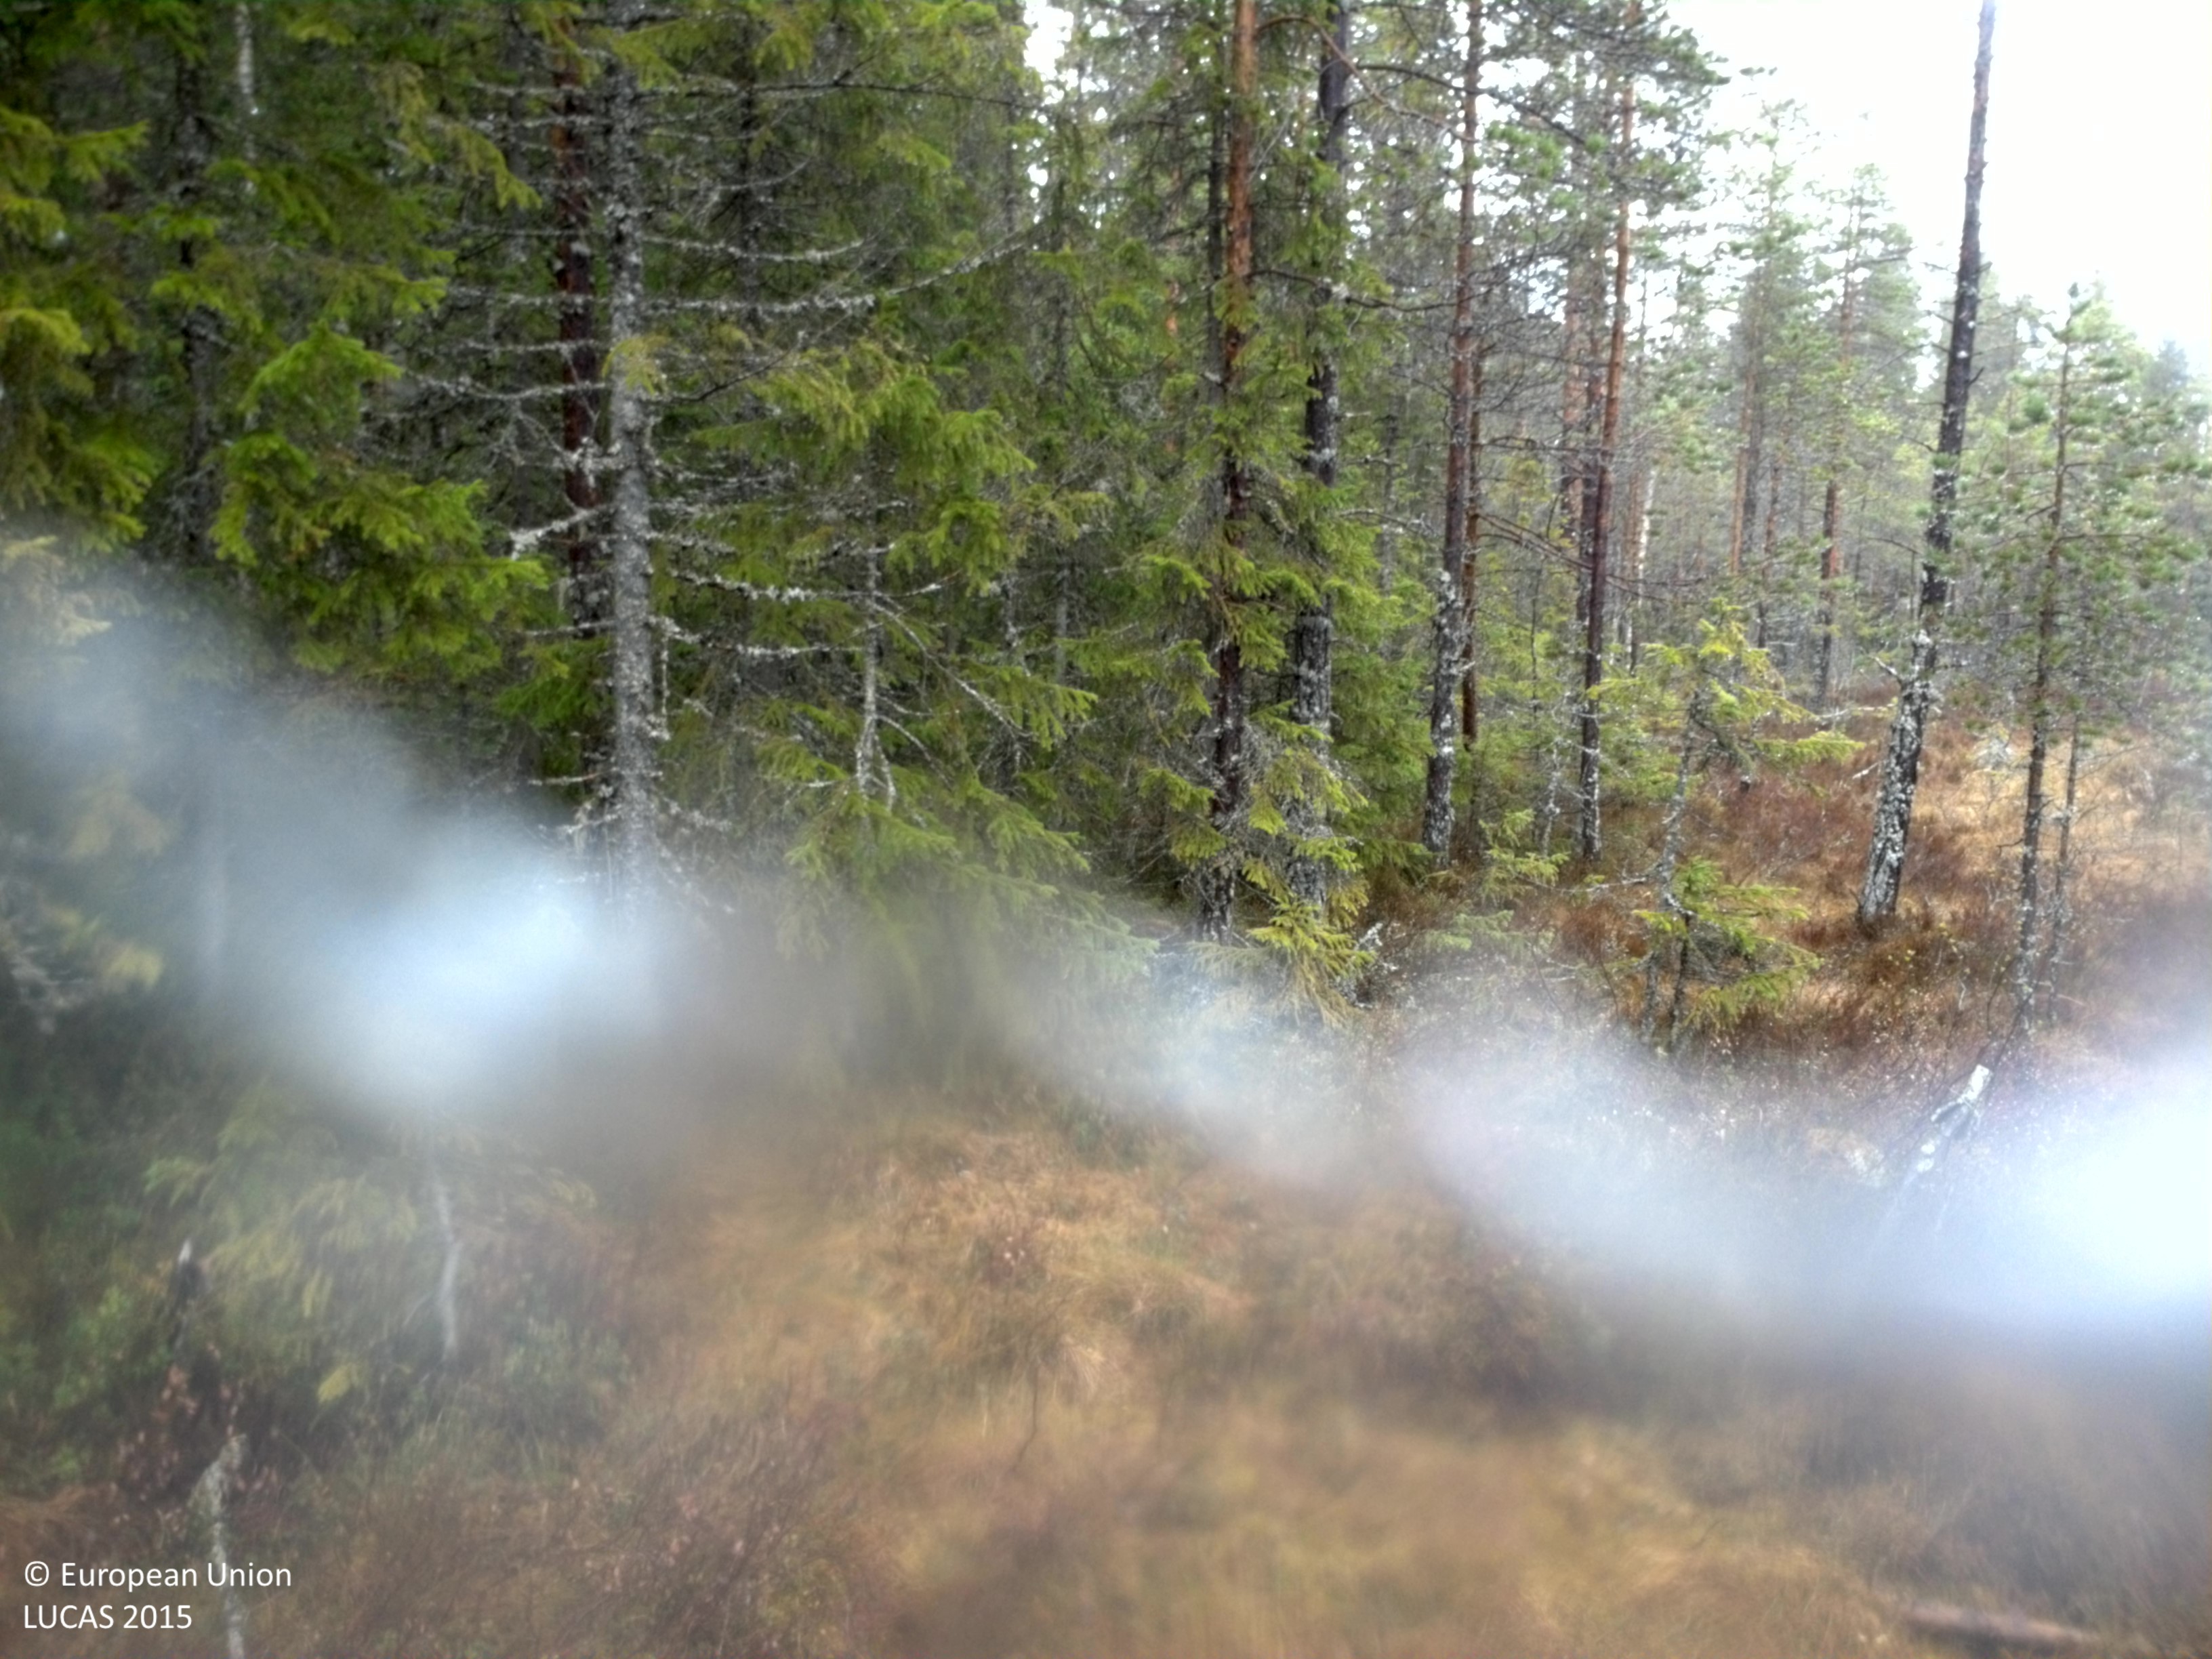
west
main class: Woodland
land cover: Pine dominated coniferous woodland
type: boreal forest
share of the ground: > 75 %
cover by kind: coniferous forest trees 80 %, herbaceous plants 20 %
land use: Forestry
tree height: > 5 m
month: May
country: SE
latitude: 61.0842
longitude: 15.0101
